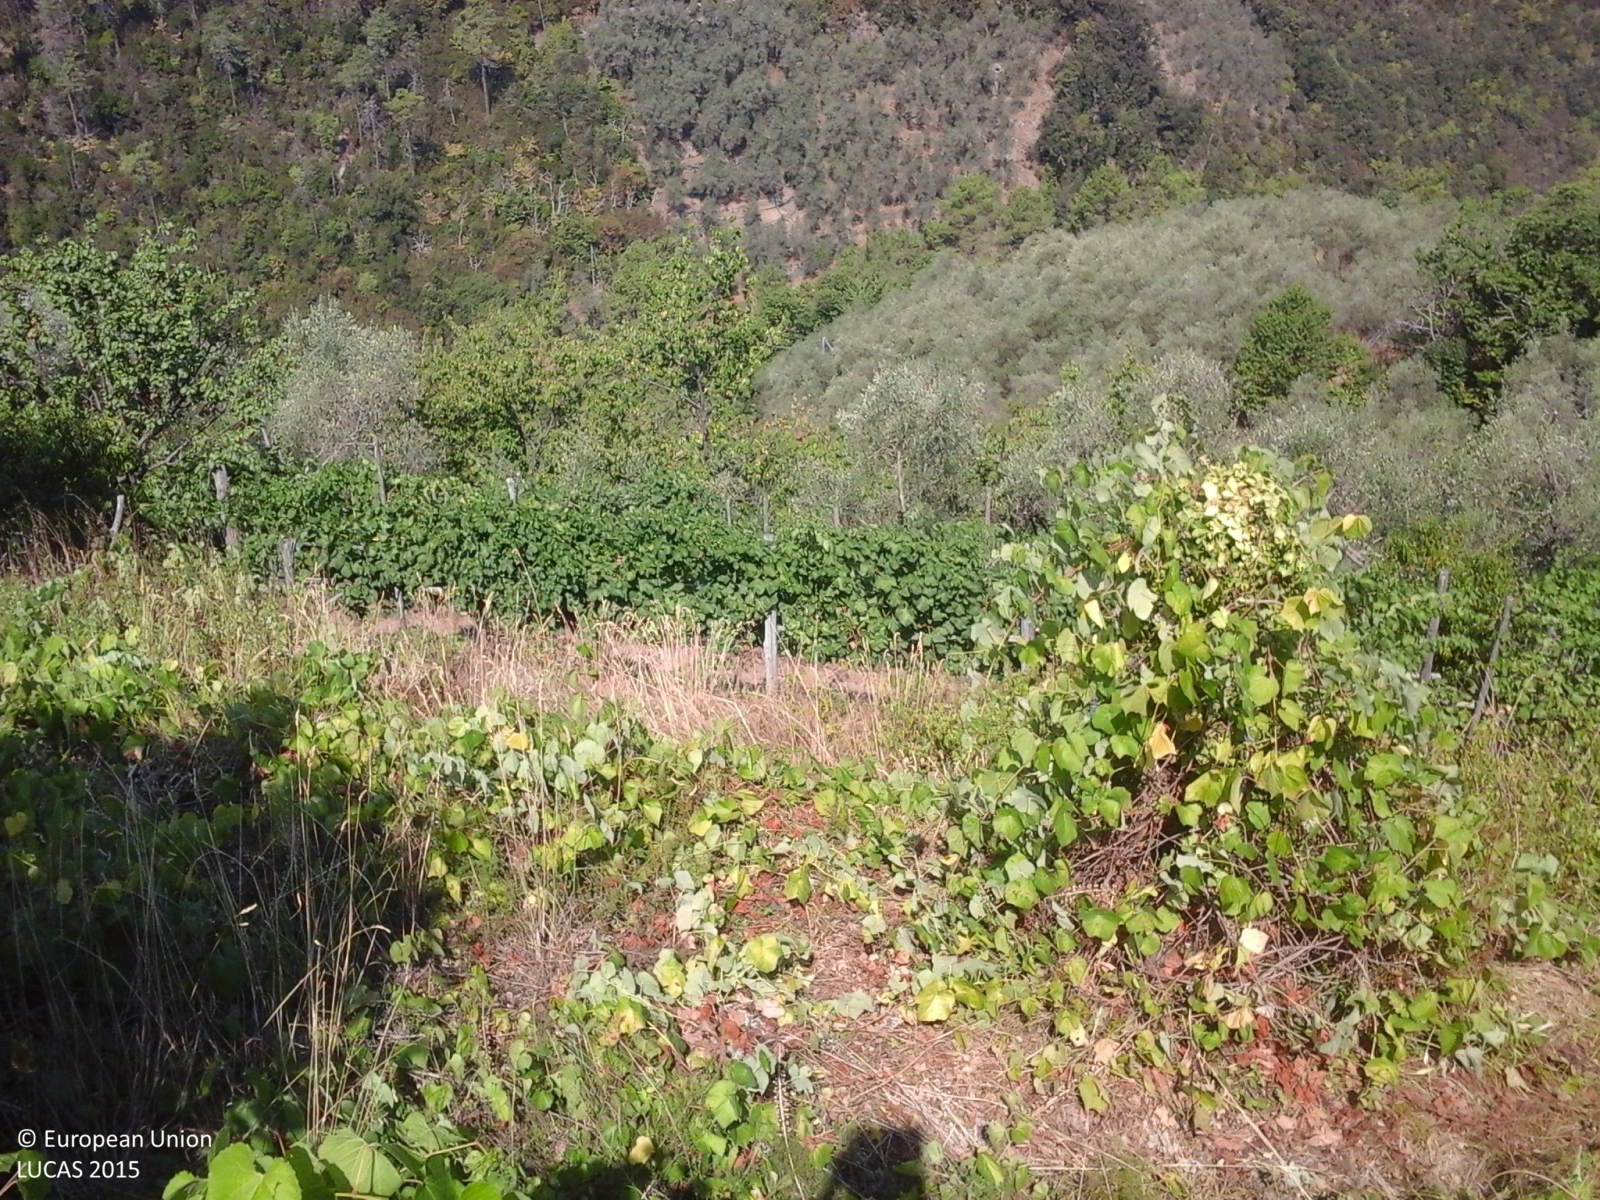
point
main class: Cropland
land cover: Olive groves
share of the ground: > 75 %
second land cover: Grassland without tree/shrub cover
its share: > 75 %
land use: Agriculture (excluding fallow land and kitchen gardens)
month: August
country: IT
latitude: 44.3308
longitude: 9.4120
